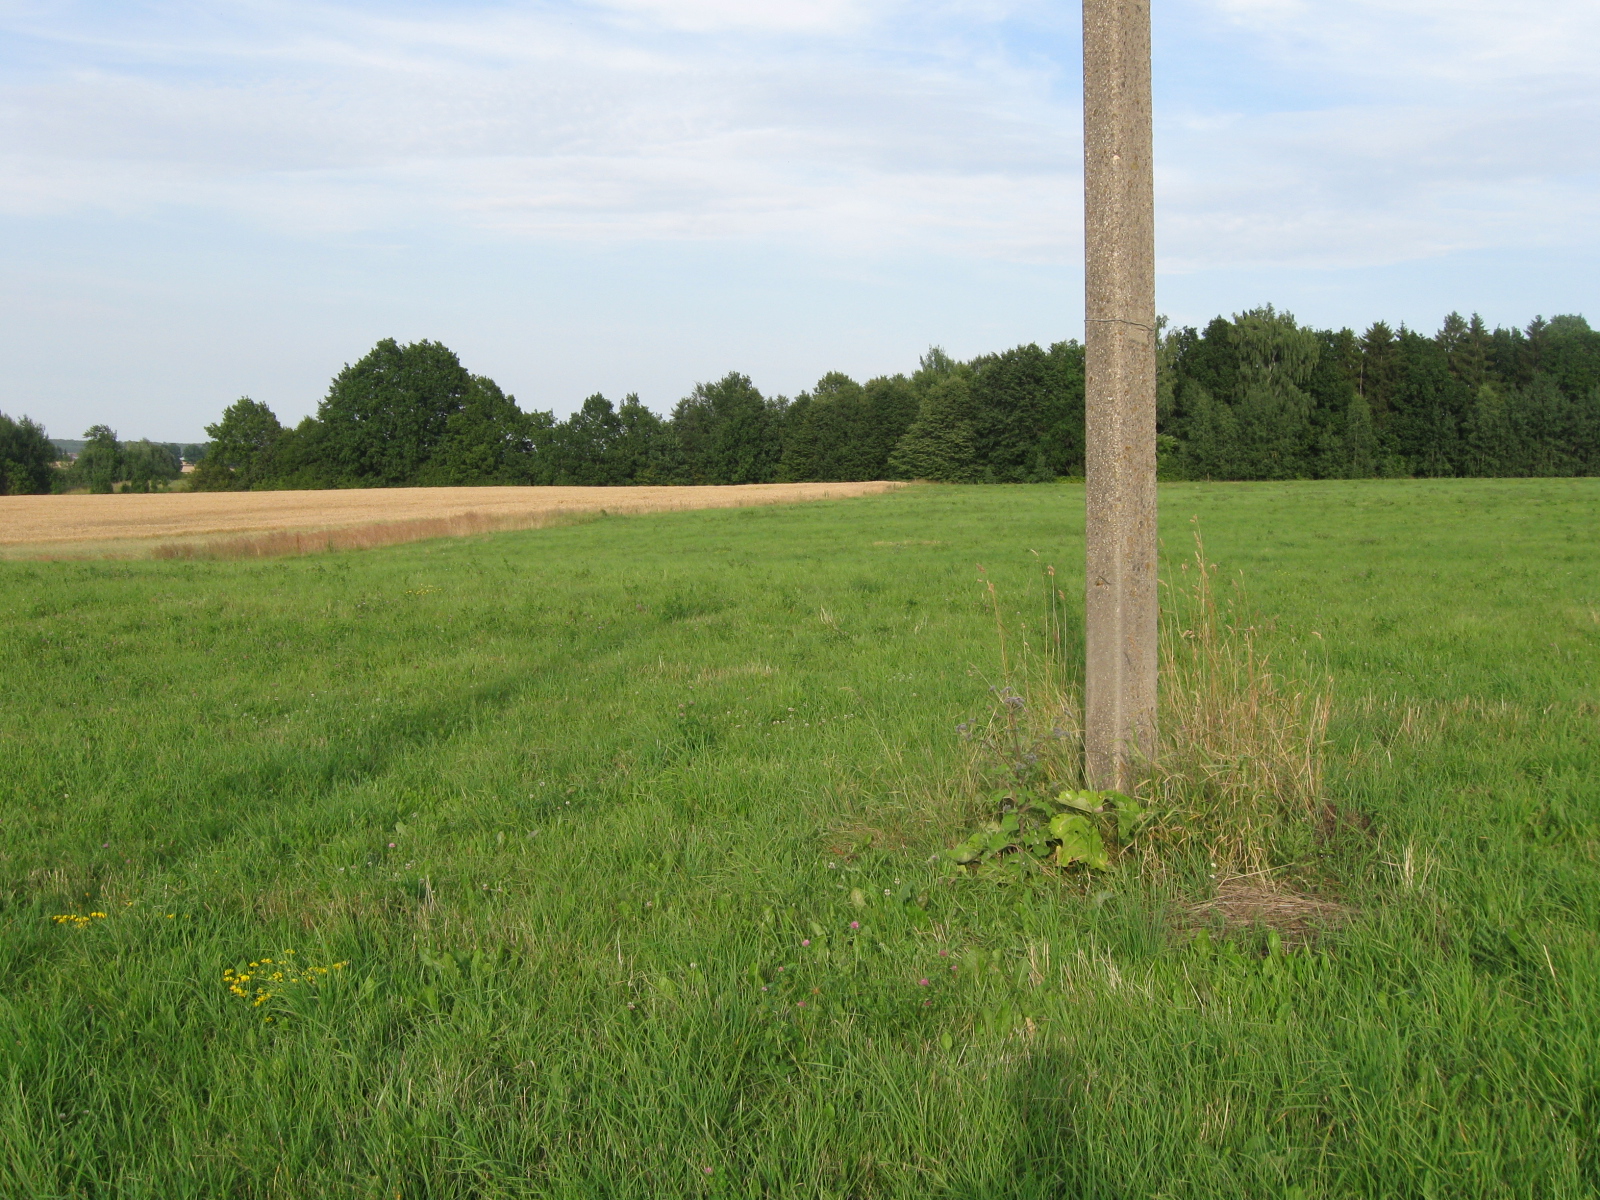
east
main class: Grassland
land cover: Grassland without tree/shrub cover
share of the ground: > 75 %
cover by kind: herbaceous plants 100 %
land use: Agriculture (excluding fallow land and kitchen gardens)
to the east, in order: Grassland without tree/shrub cover; Electric lines; Grassland without tree/shrub cover; Electric lines; Grassland without tree/shrub cover; Common wheat; Broadleaved woodland; Rivers and streams; Broadleaved woodland; Grassland without tree/shrub cover
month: July
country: LT
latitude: 54.6723
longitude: 23.7795
